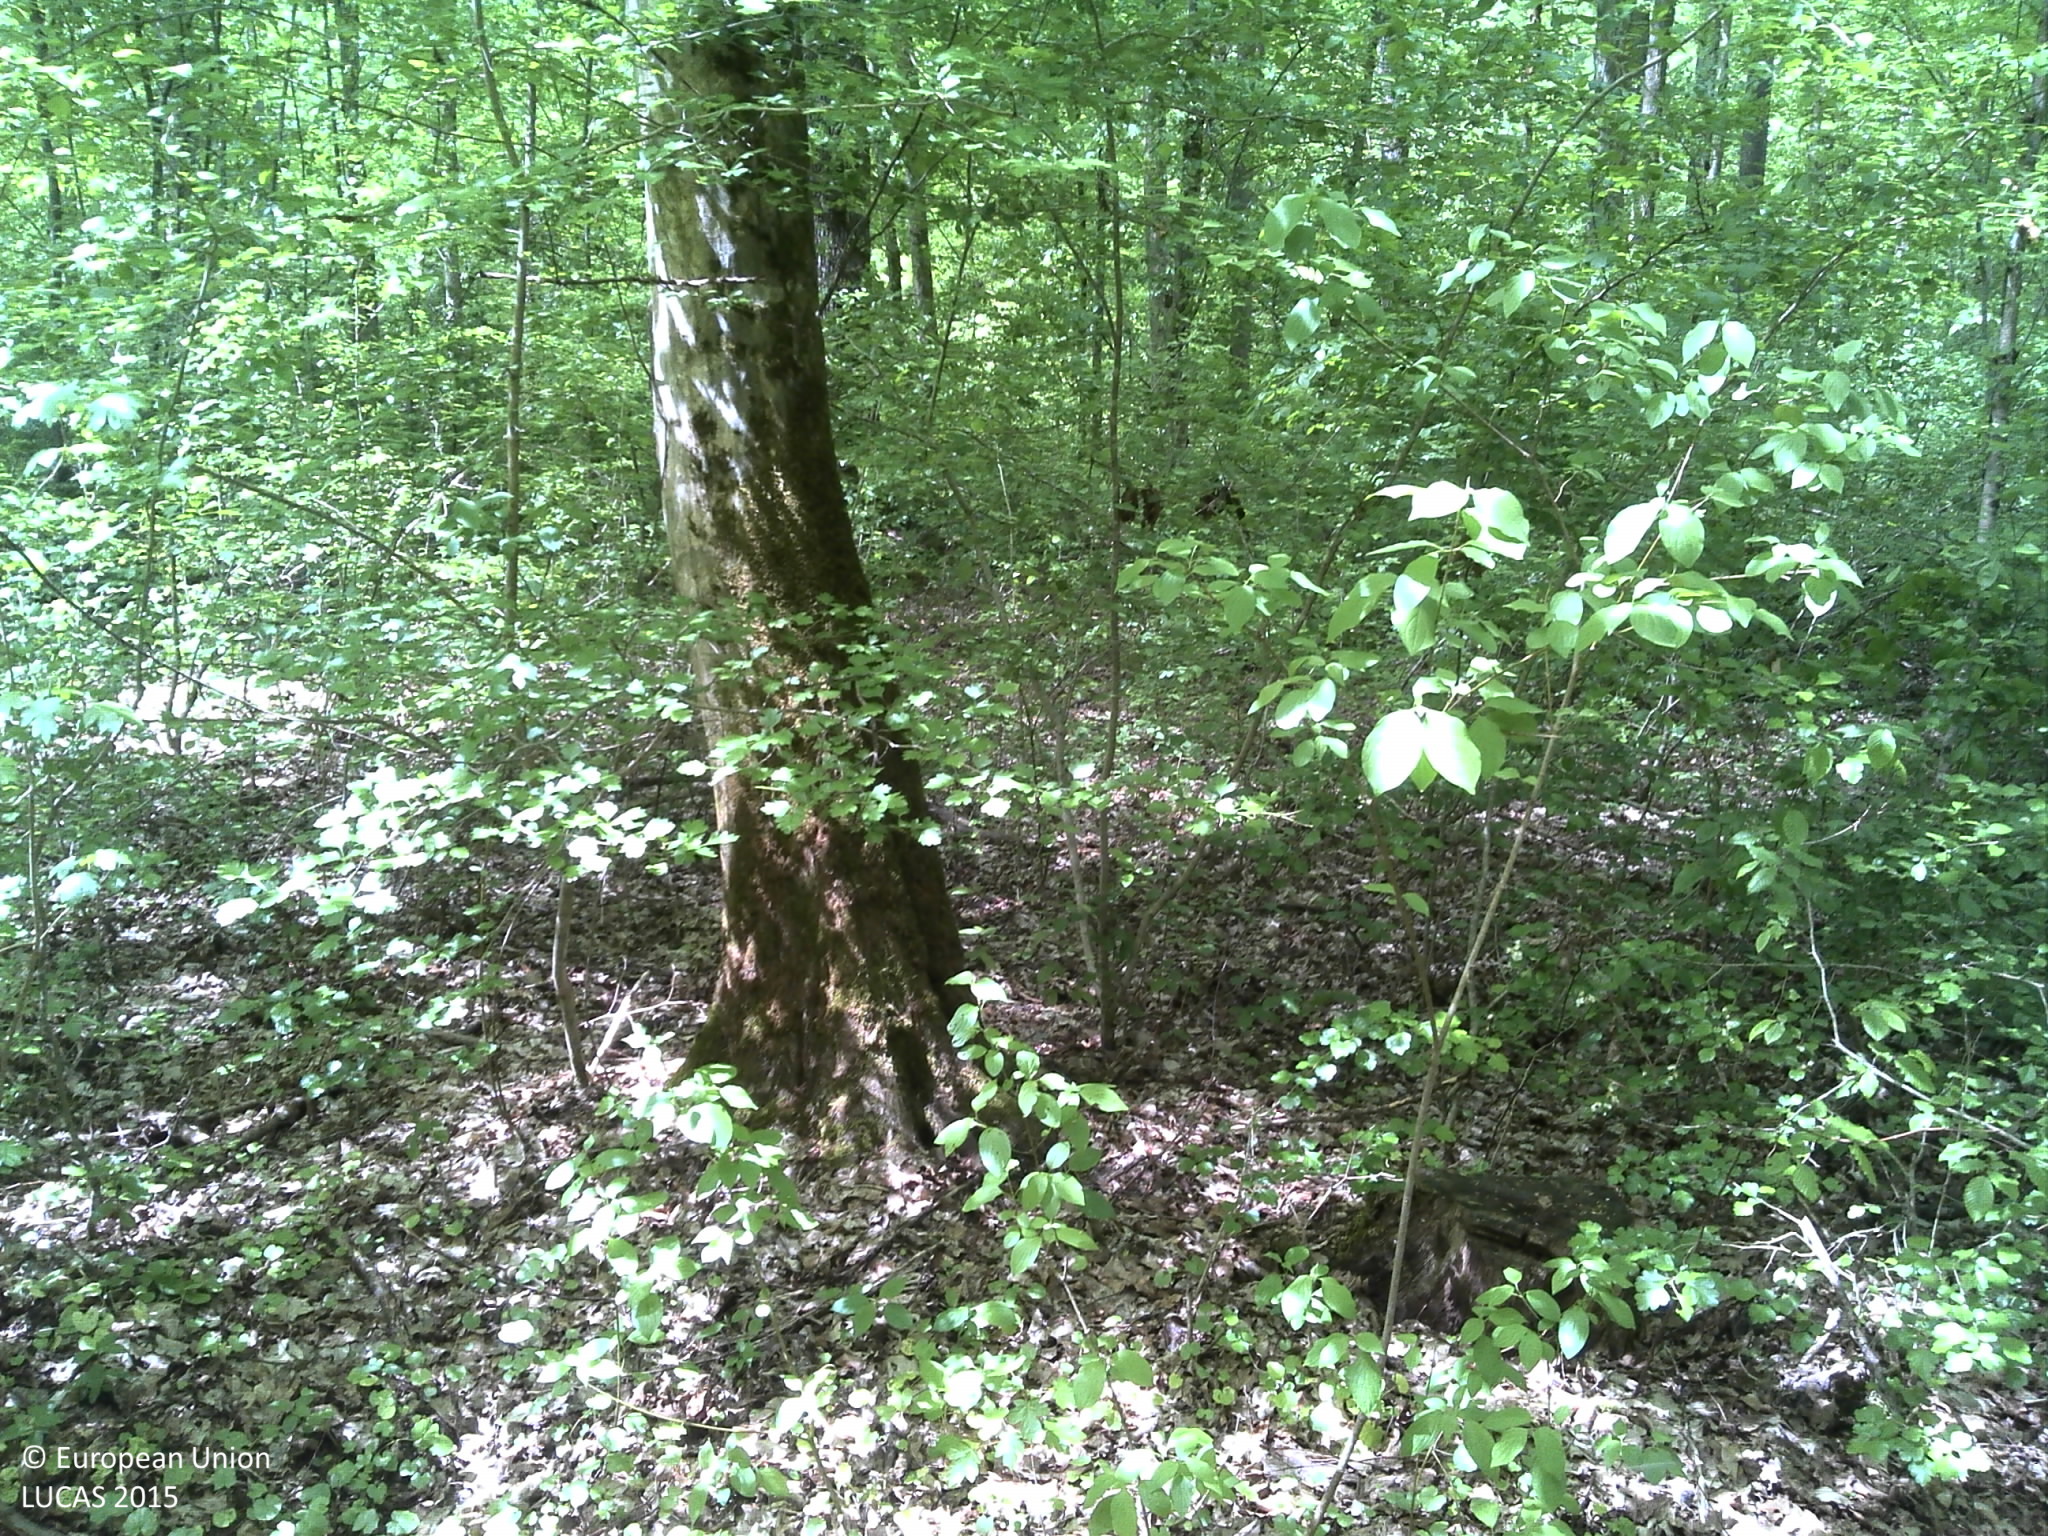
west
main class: Woodland
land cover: Broadleaved woodland
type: mesophytic deciduous forest
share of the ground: > 75 %
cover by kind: broadleaved forest trees 100 %
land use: Forestry
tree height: > 5 m
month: April
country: HR
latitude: 45.0769
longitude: 18.8605
